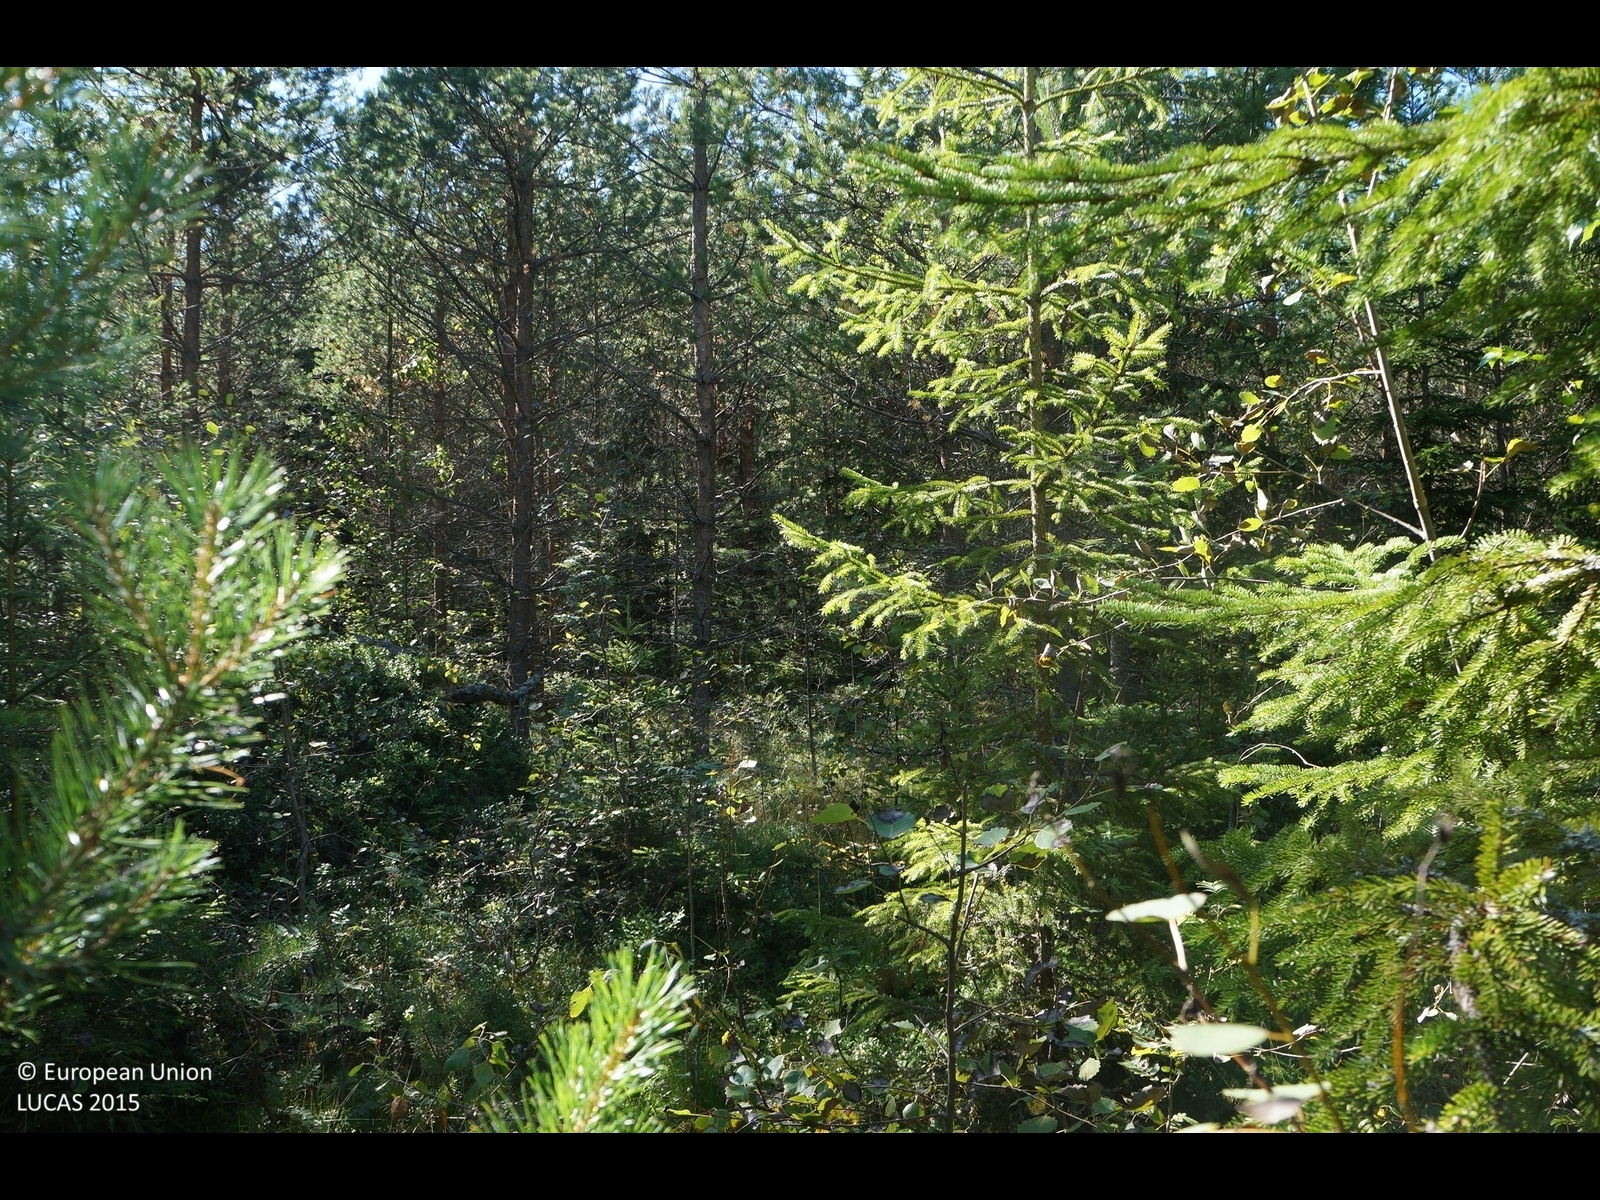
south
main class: Woodland
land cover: Other mixed woodland
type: boreal forest
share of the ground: 50 - 75 %
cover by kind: coniferous forest trees 50 %, shrubs 30 %, broadleaved forest trees 20 %
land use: Forestry
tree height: > 5 m
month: August
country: FI
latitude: 63.7362
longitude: 22.9539
